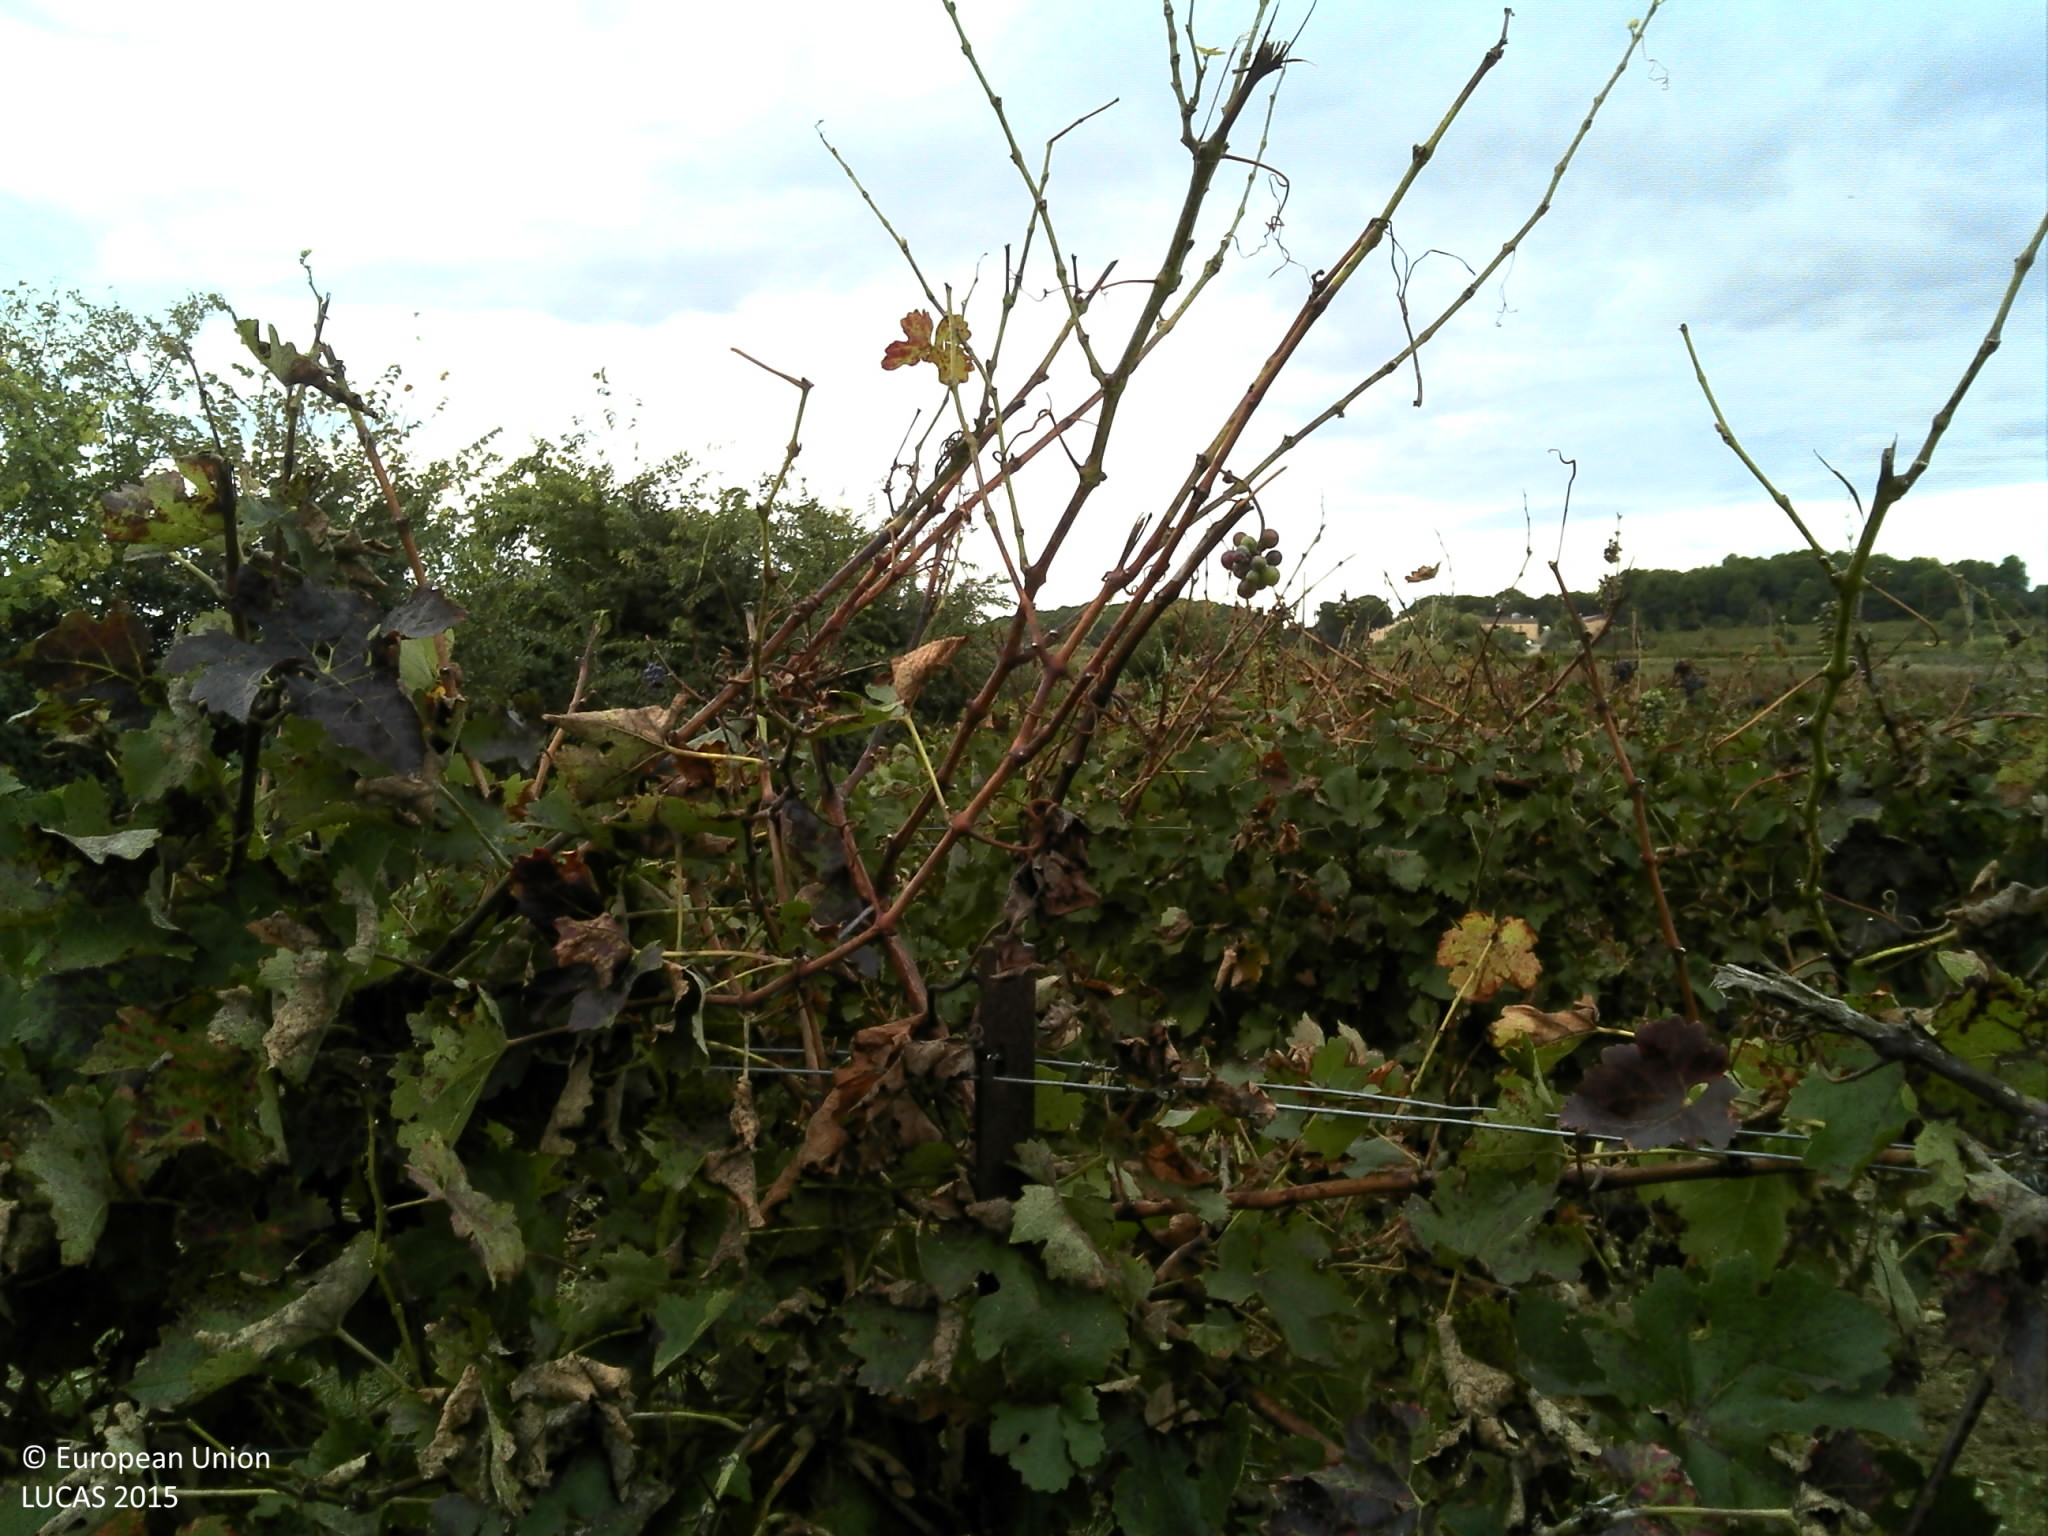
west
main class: Cropland
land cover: Vineyards
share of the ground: 10 - 25 %
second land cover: Other bare soil
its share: > 75 %
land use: Agriculture (excluding fallow land and kitchen gardens)
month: October
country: FR
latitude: 43.3596
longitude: 3.0870
